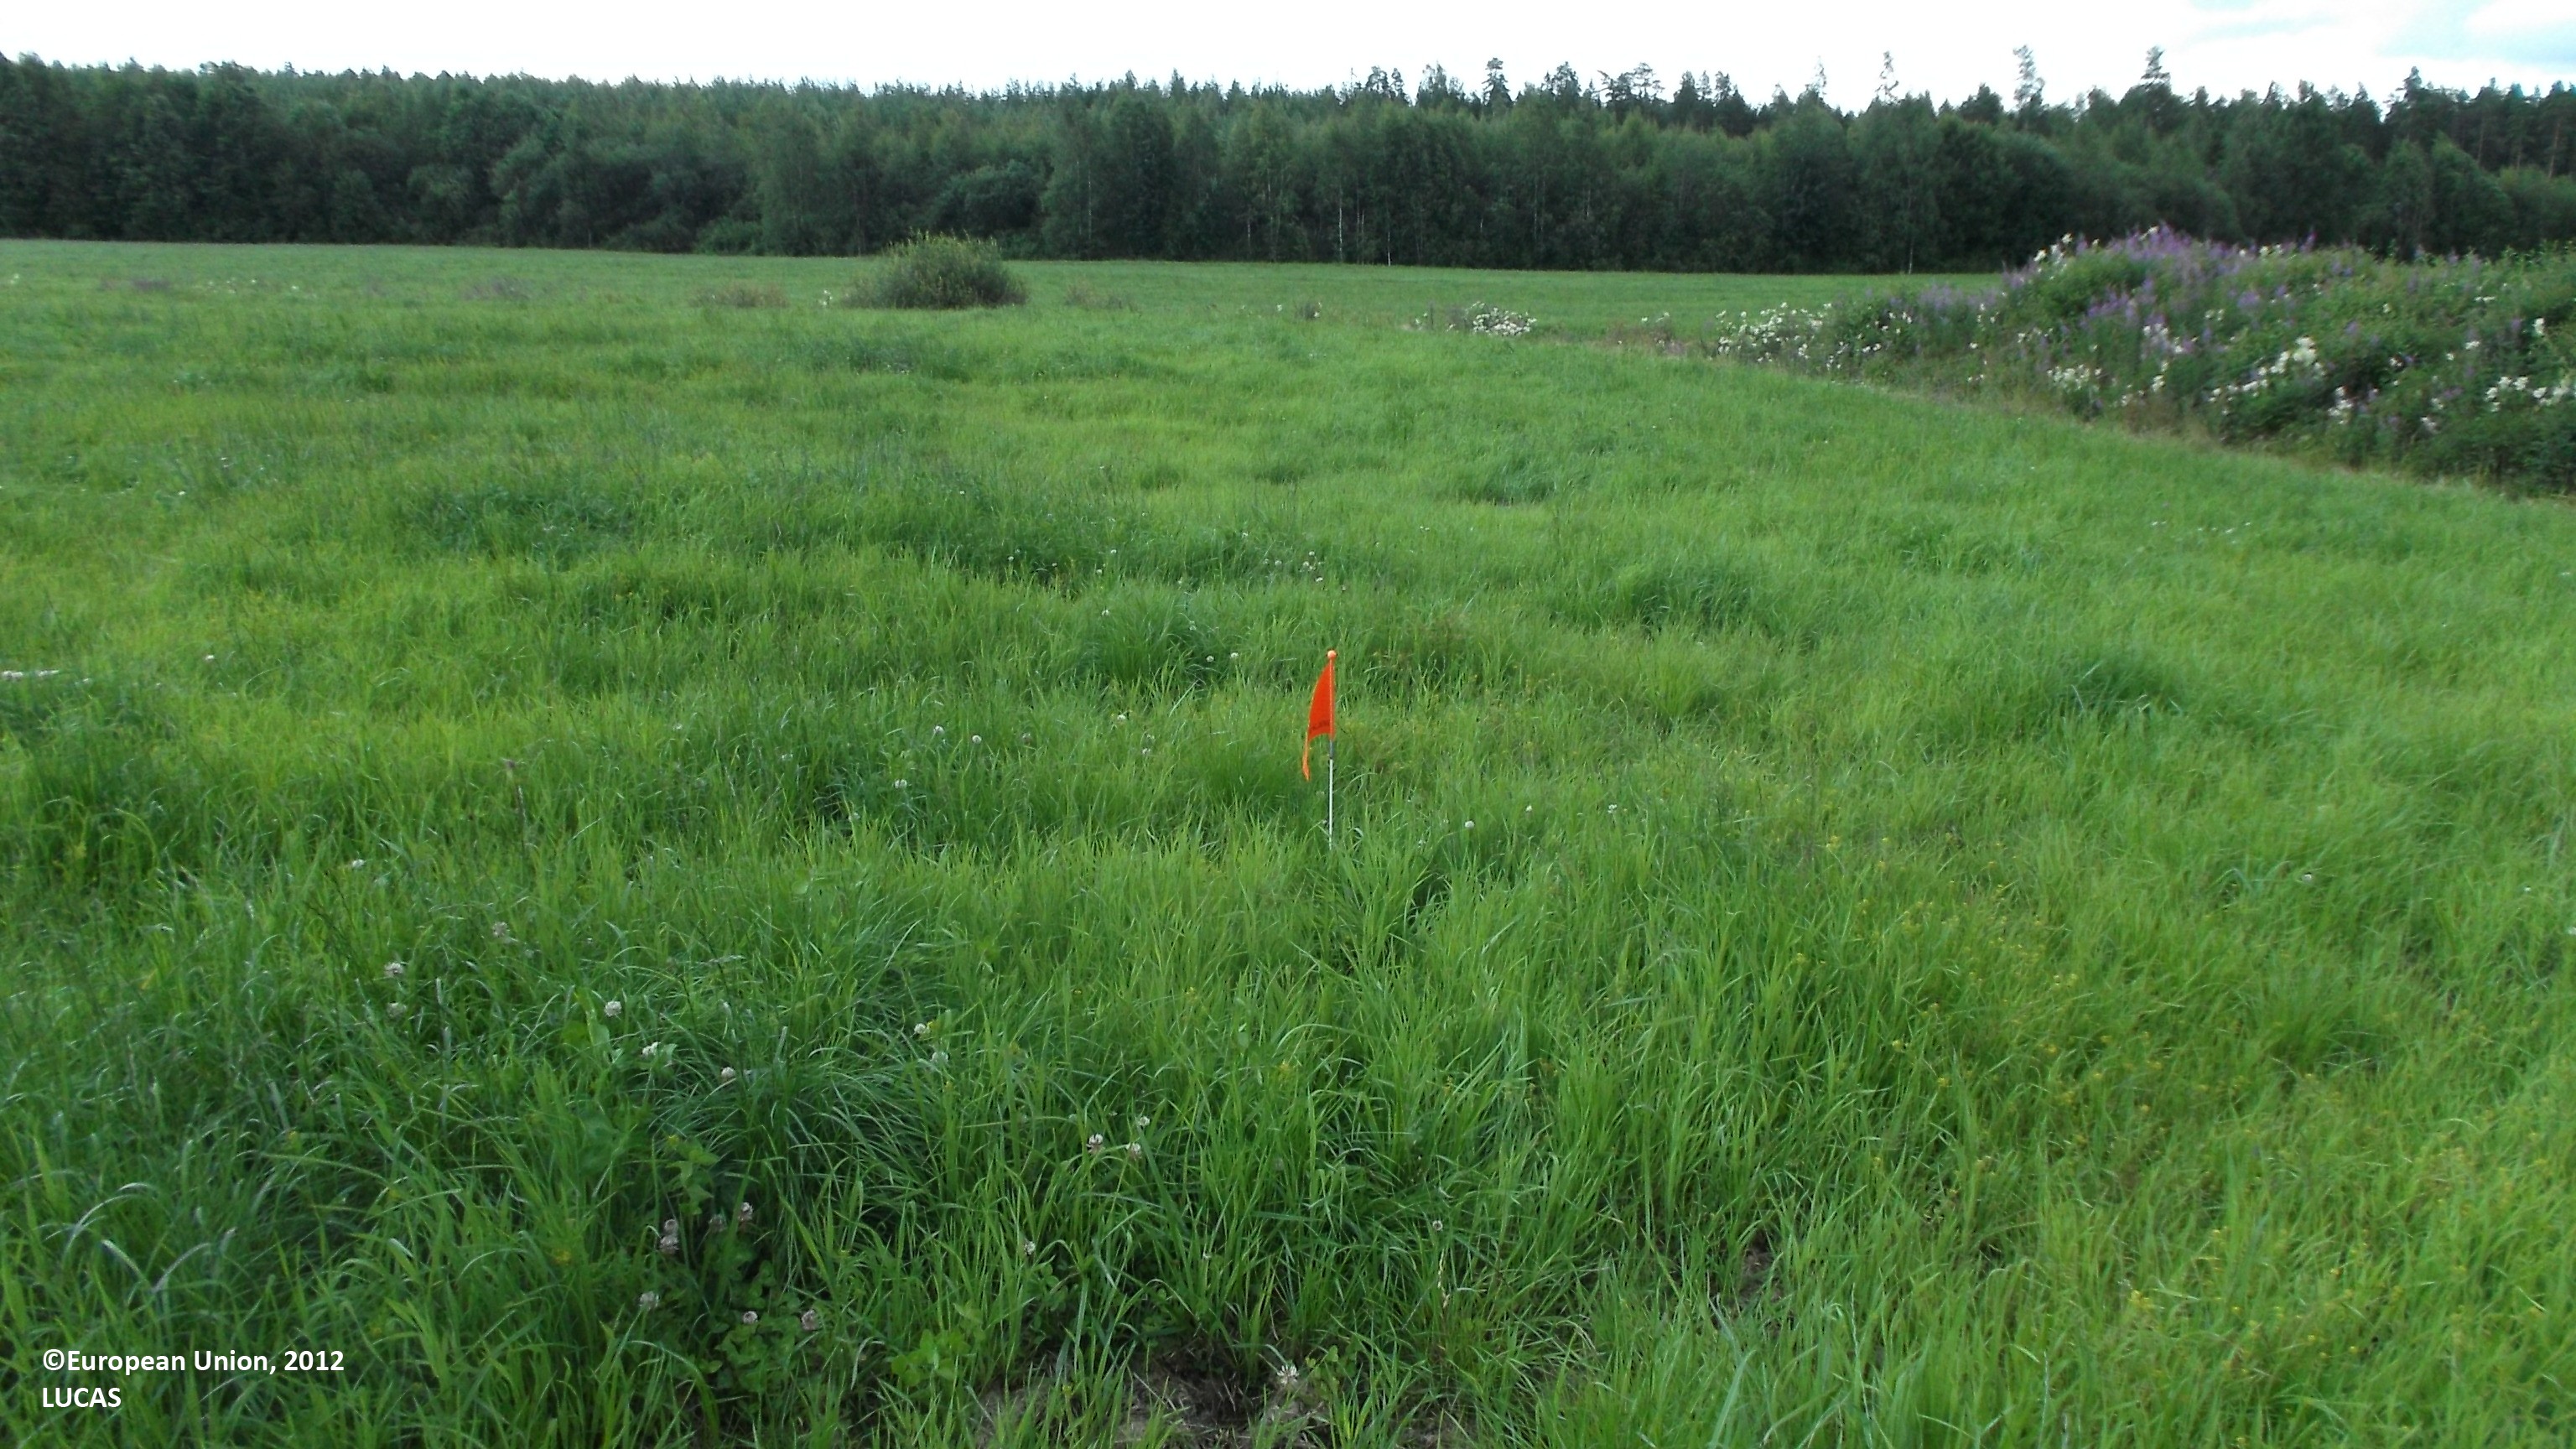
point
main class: Cropland
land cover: Temporary grasslands
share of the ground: > 75 %
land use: Agriculture (excluding fallow land and kitchen gardens)
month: July
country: FI
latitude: 63.6849
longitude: 23.3412
